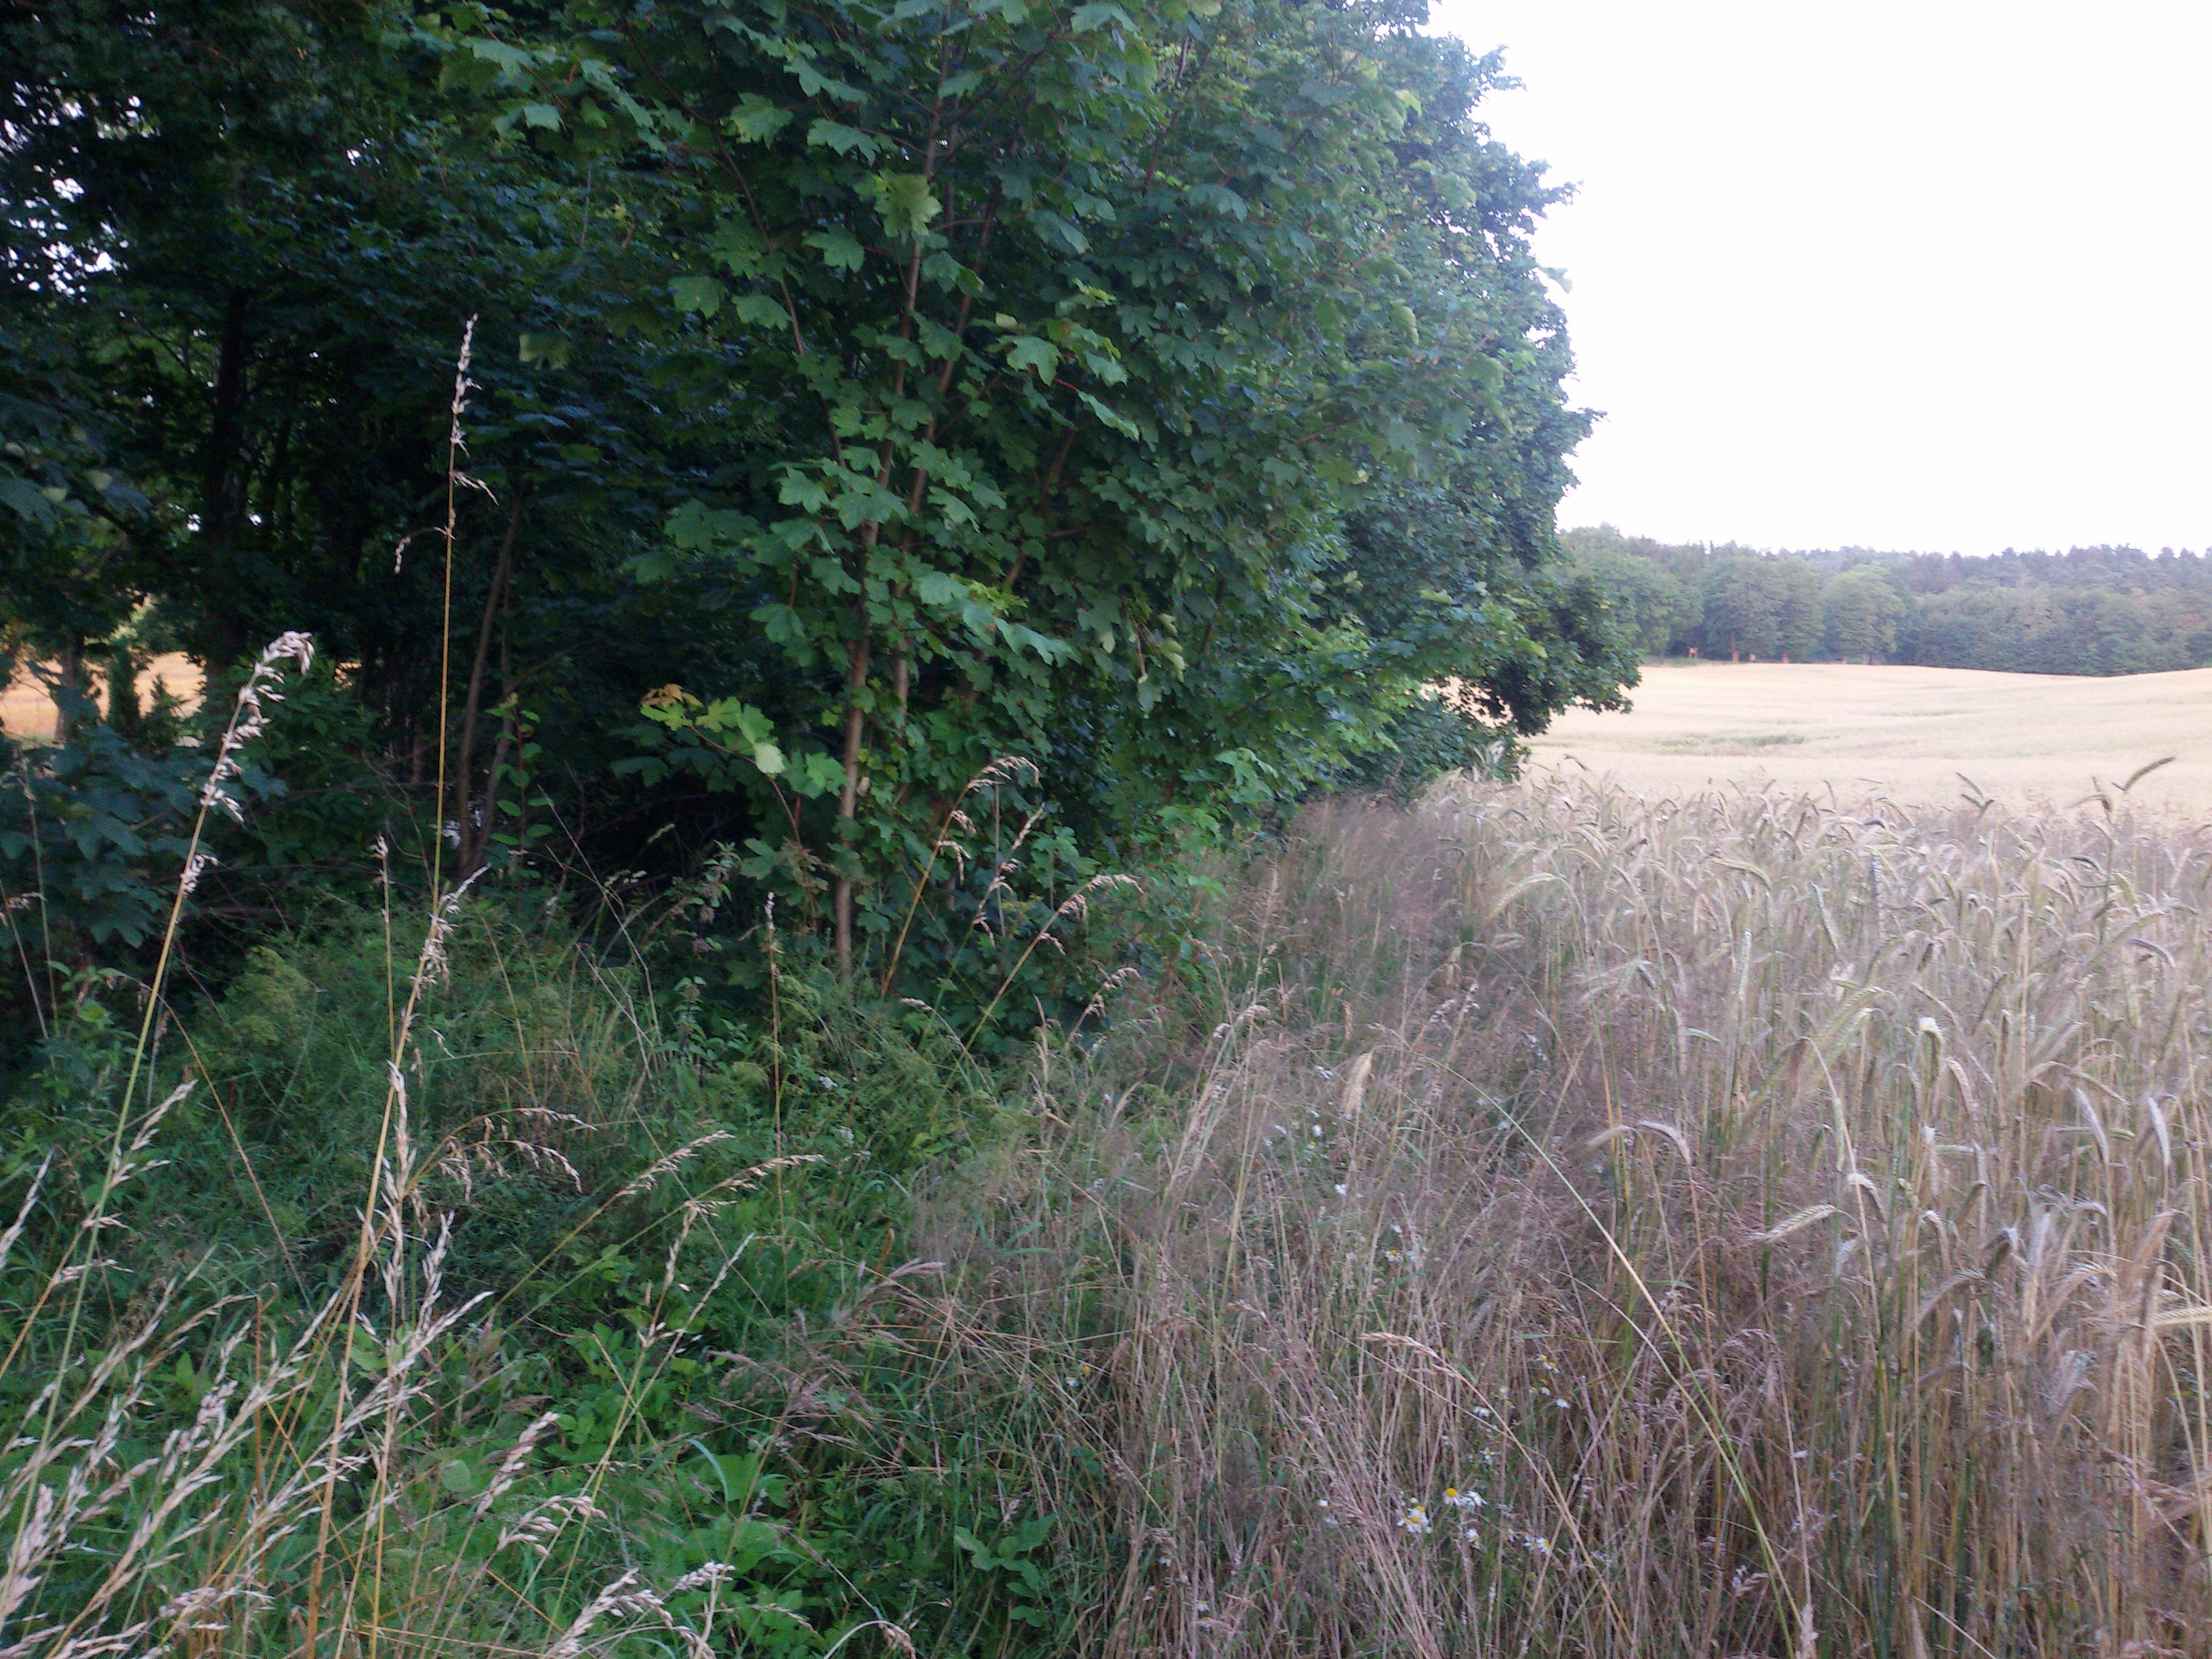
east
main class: Cropland
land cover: Rye
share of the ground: > 75 %
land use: Agriculture (excluding fallow land and kitchen gardens)
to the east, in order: Rye
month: July
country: PL
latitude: 53.8371
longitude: 15.8547
